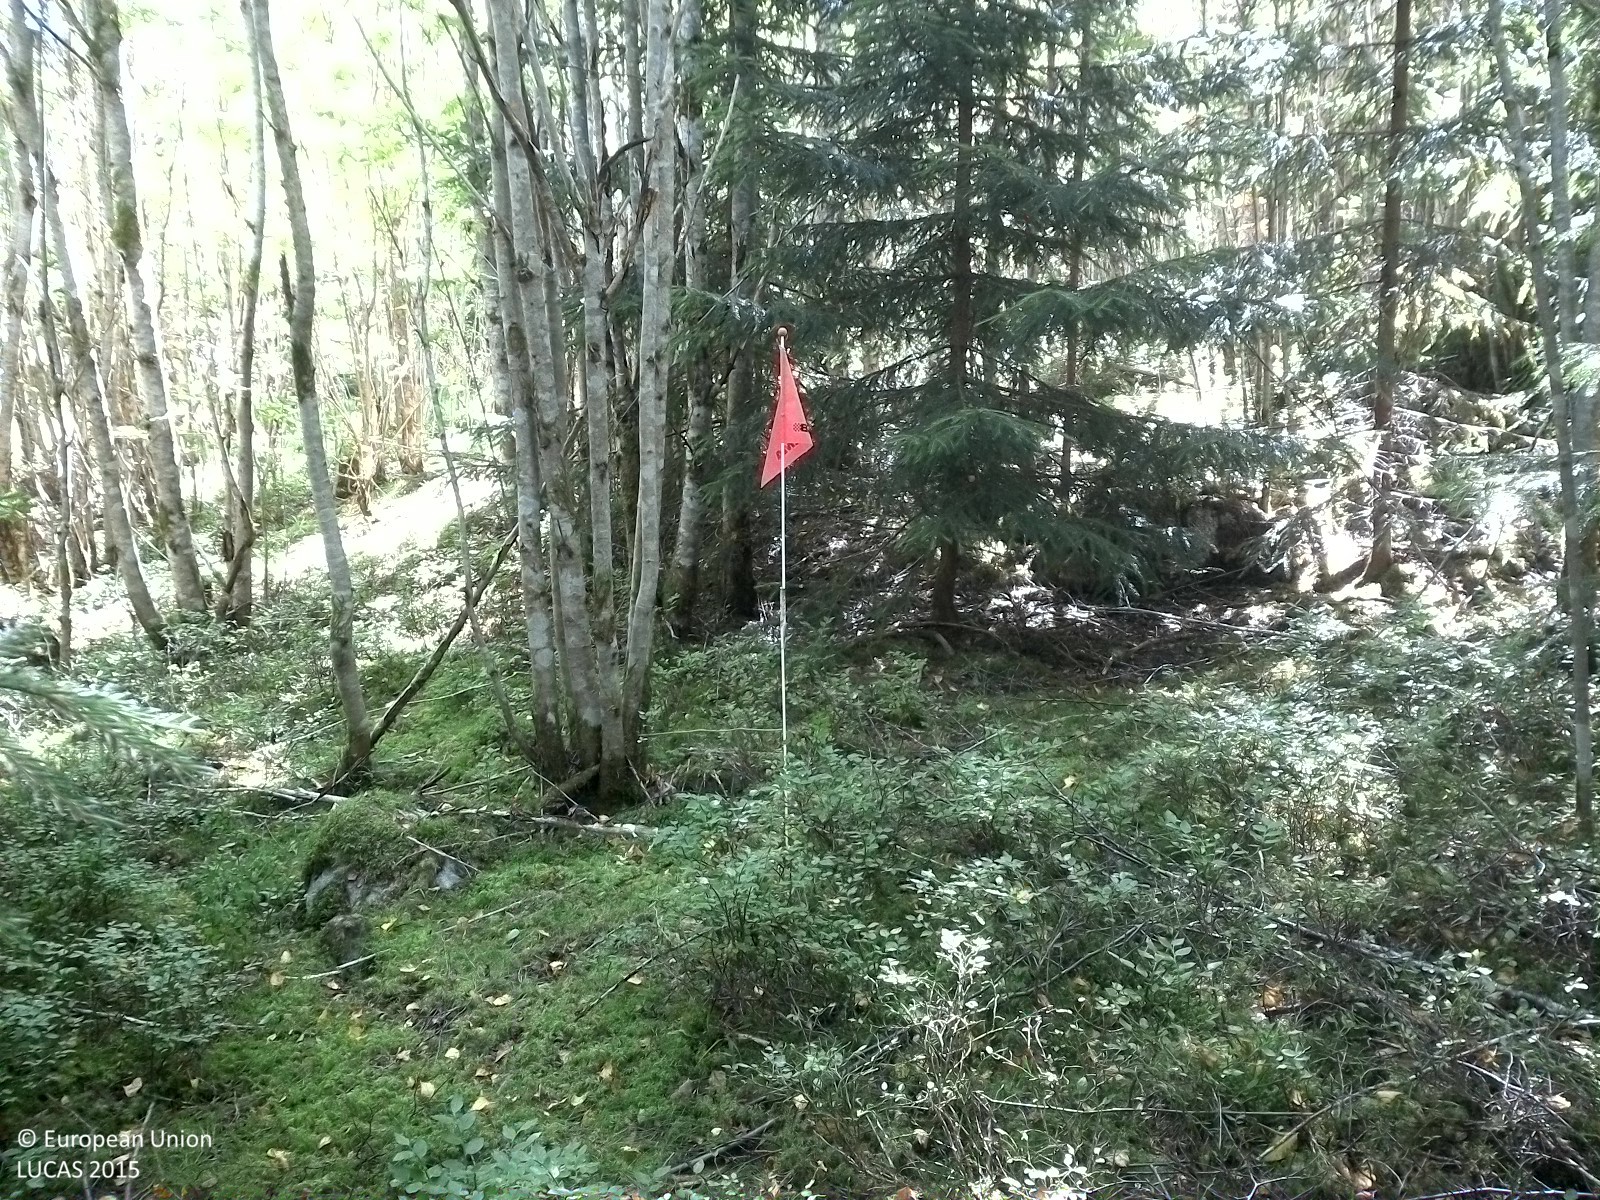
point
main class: Woodland
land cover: Spruce dominated mixed woodland
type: boreal forest
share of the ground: 50 - 75 %
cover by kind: coniferous forest trees 35 %, broadleaved forest trees 30 %, herbaceous plants 20 %, lichens and mosses 15 %
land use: Forestry
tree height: < 5 m
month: August
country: SE
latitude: 59.2701
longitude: 14.7813
